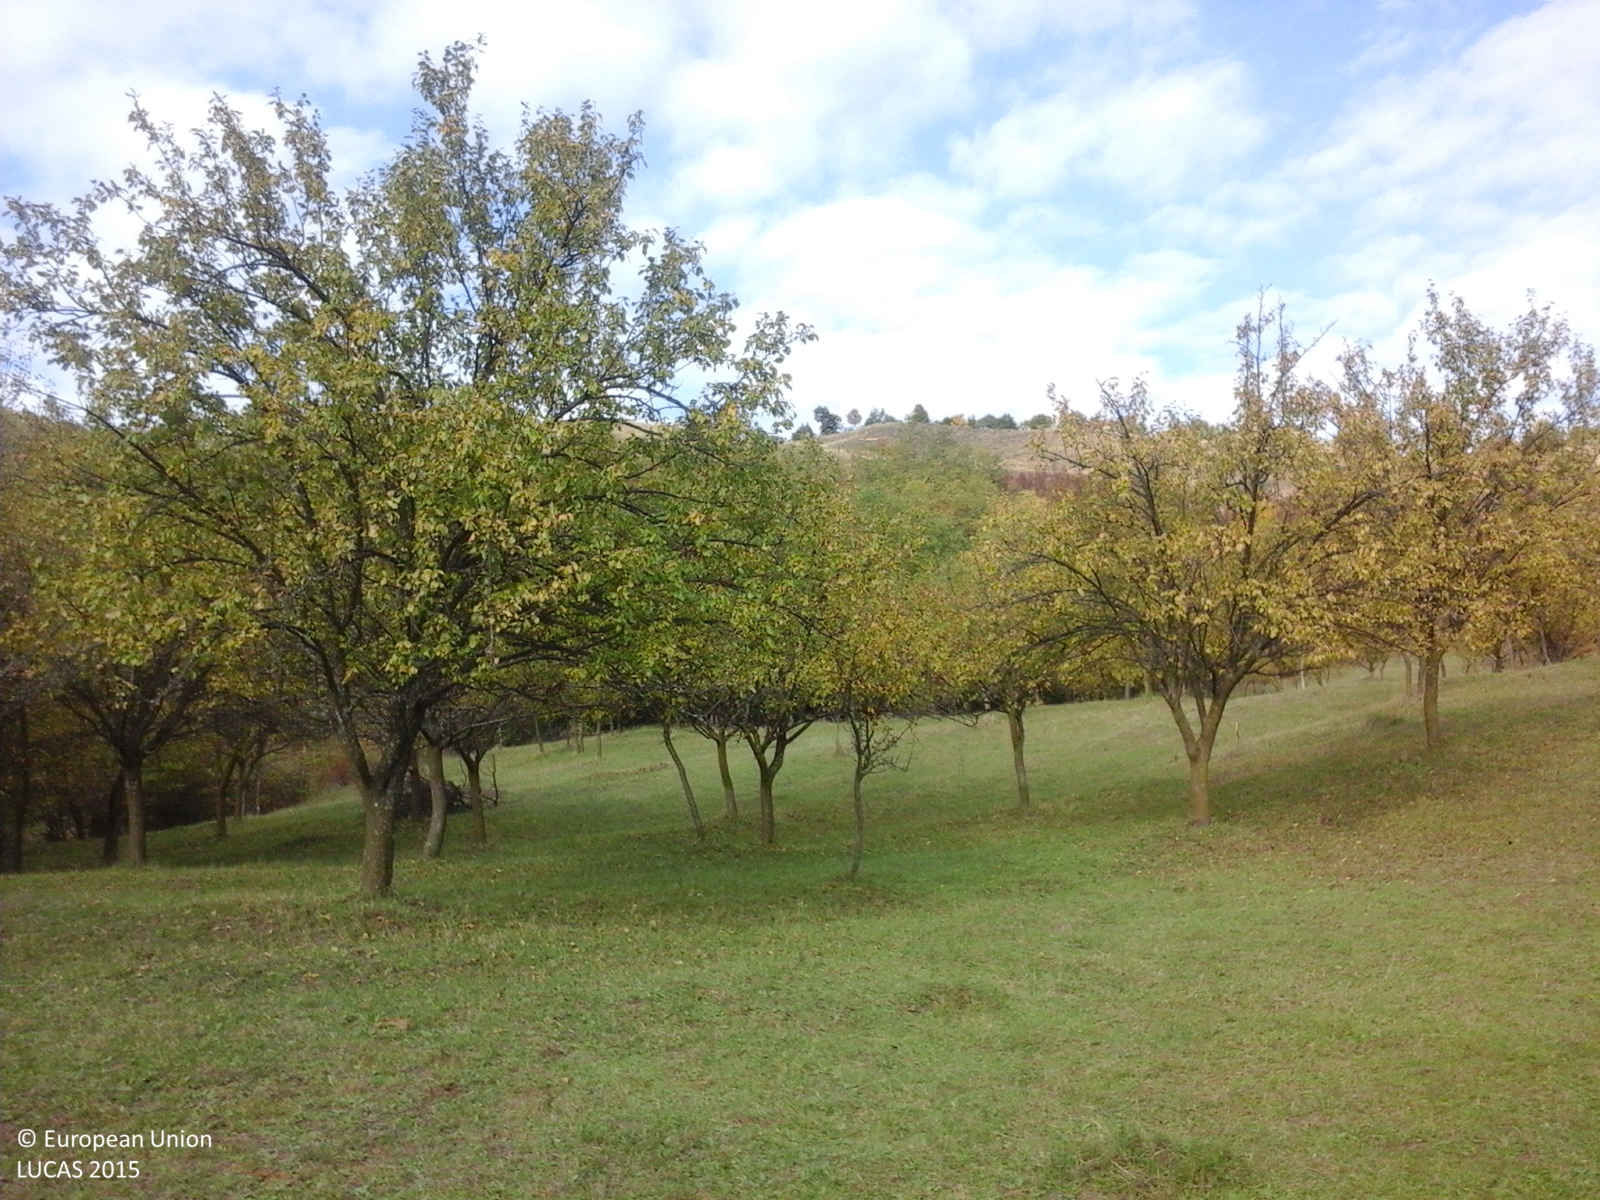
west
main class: Cropland
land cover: Other fruit trees and berries
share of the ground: 50 - 75 %
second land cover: Grassland without tree/shrub cover
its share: > 75 %
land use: Agriculture (excluding fallow land and kitchen gardens)
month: October
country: RO
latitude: 45.1519
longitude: 26.2571
